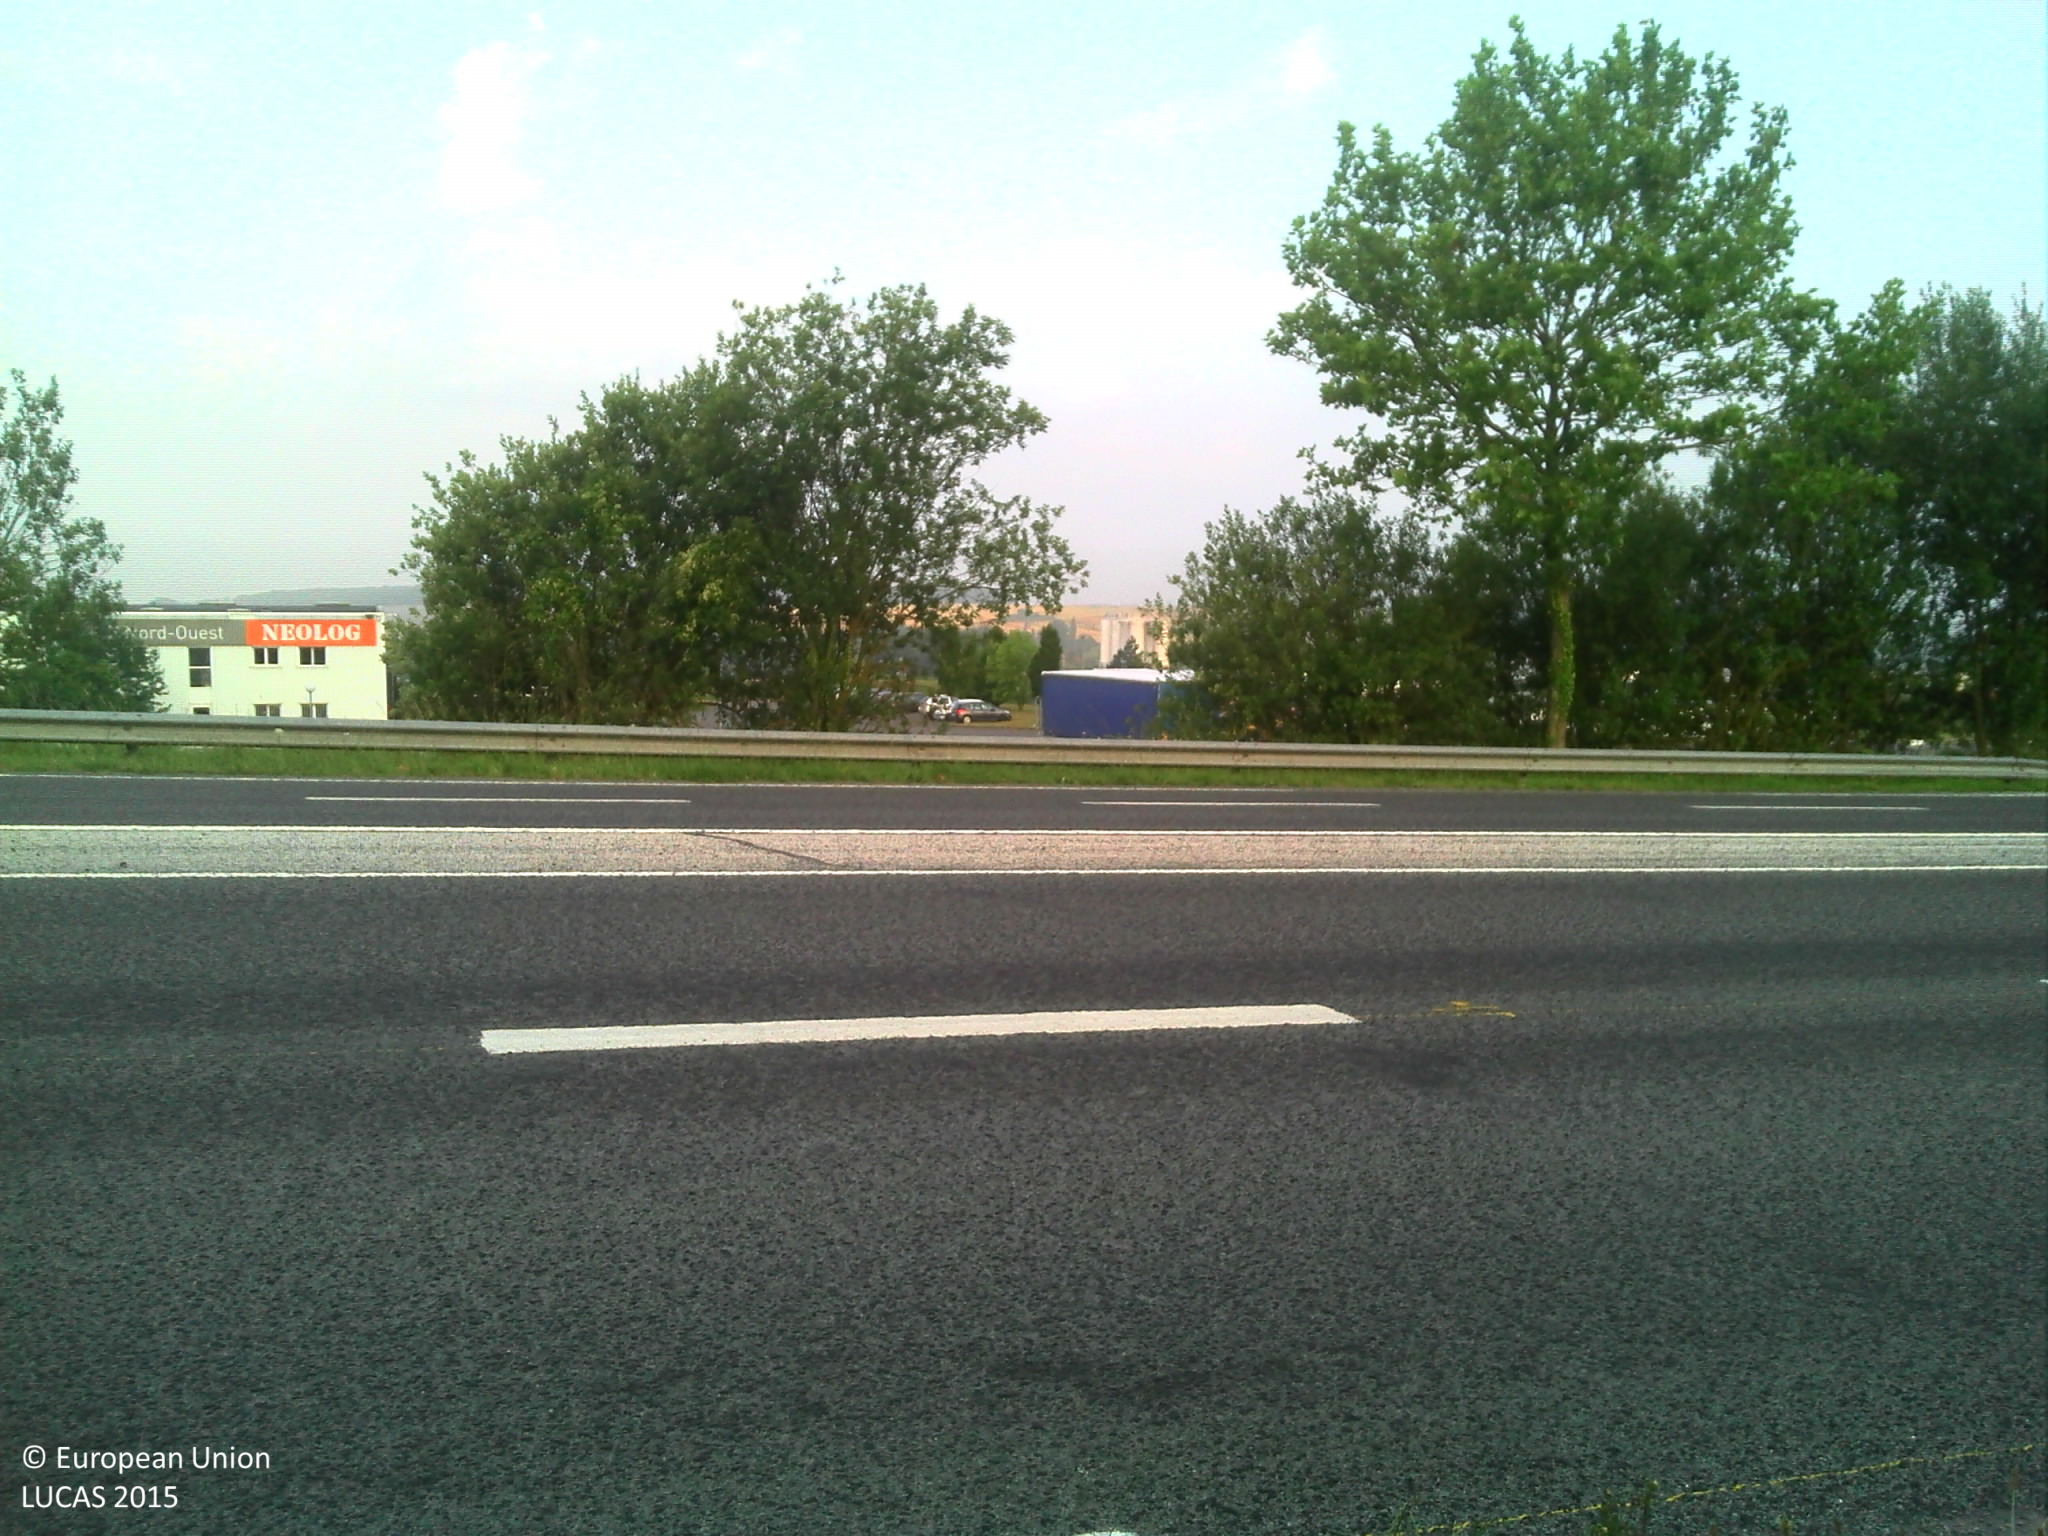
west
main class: Cropland
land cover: Common wheat
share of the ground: > 75 %
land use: Agriculture (excluding fallow land and kitchen gardens)
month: July
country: FR
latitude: 49.7908
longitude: 2.4727
